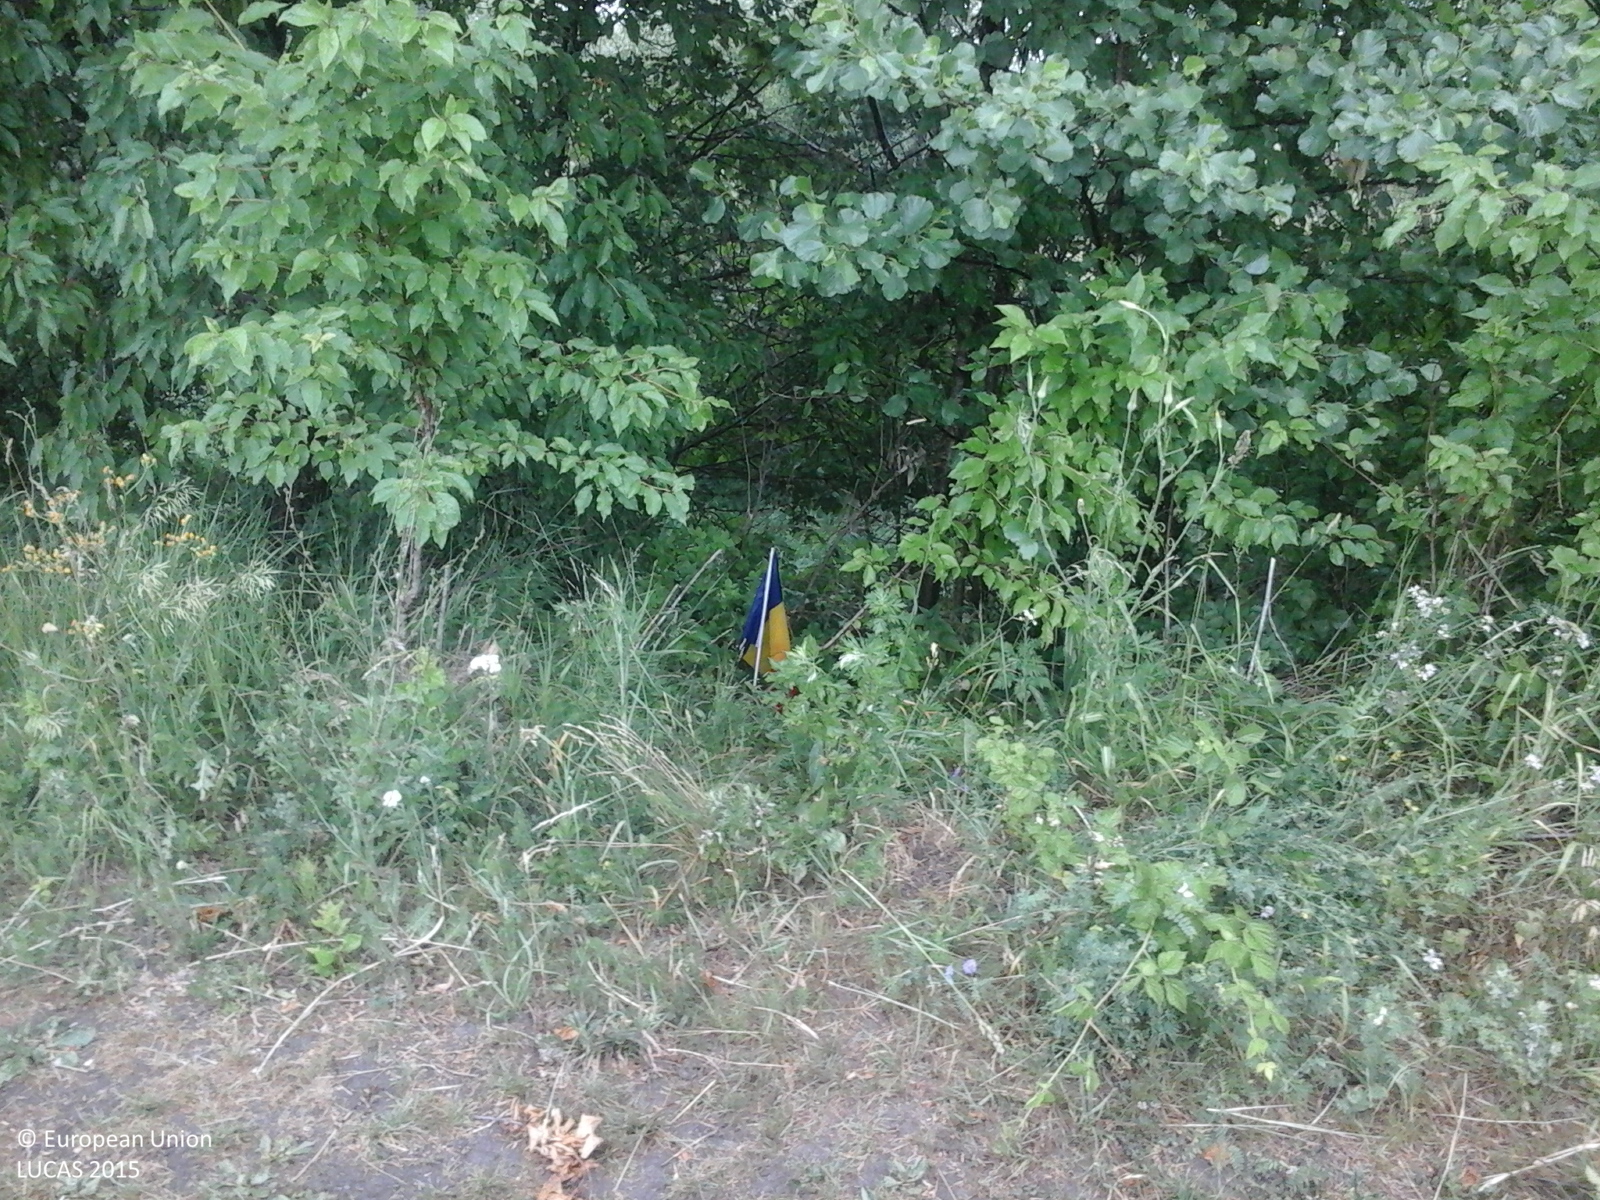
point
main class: Woodland
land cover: Broadleaved woodland
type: beech forest
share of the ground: > 75 %
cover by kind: broadleaved forest trees 100 %
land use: Forestry
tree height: > 5 m
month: June
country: RO
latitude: 47.2977
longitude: 26.3905
